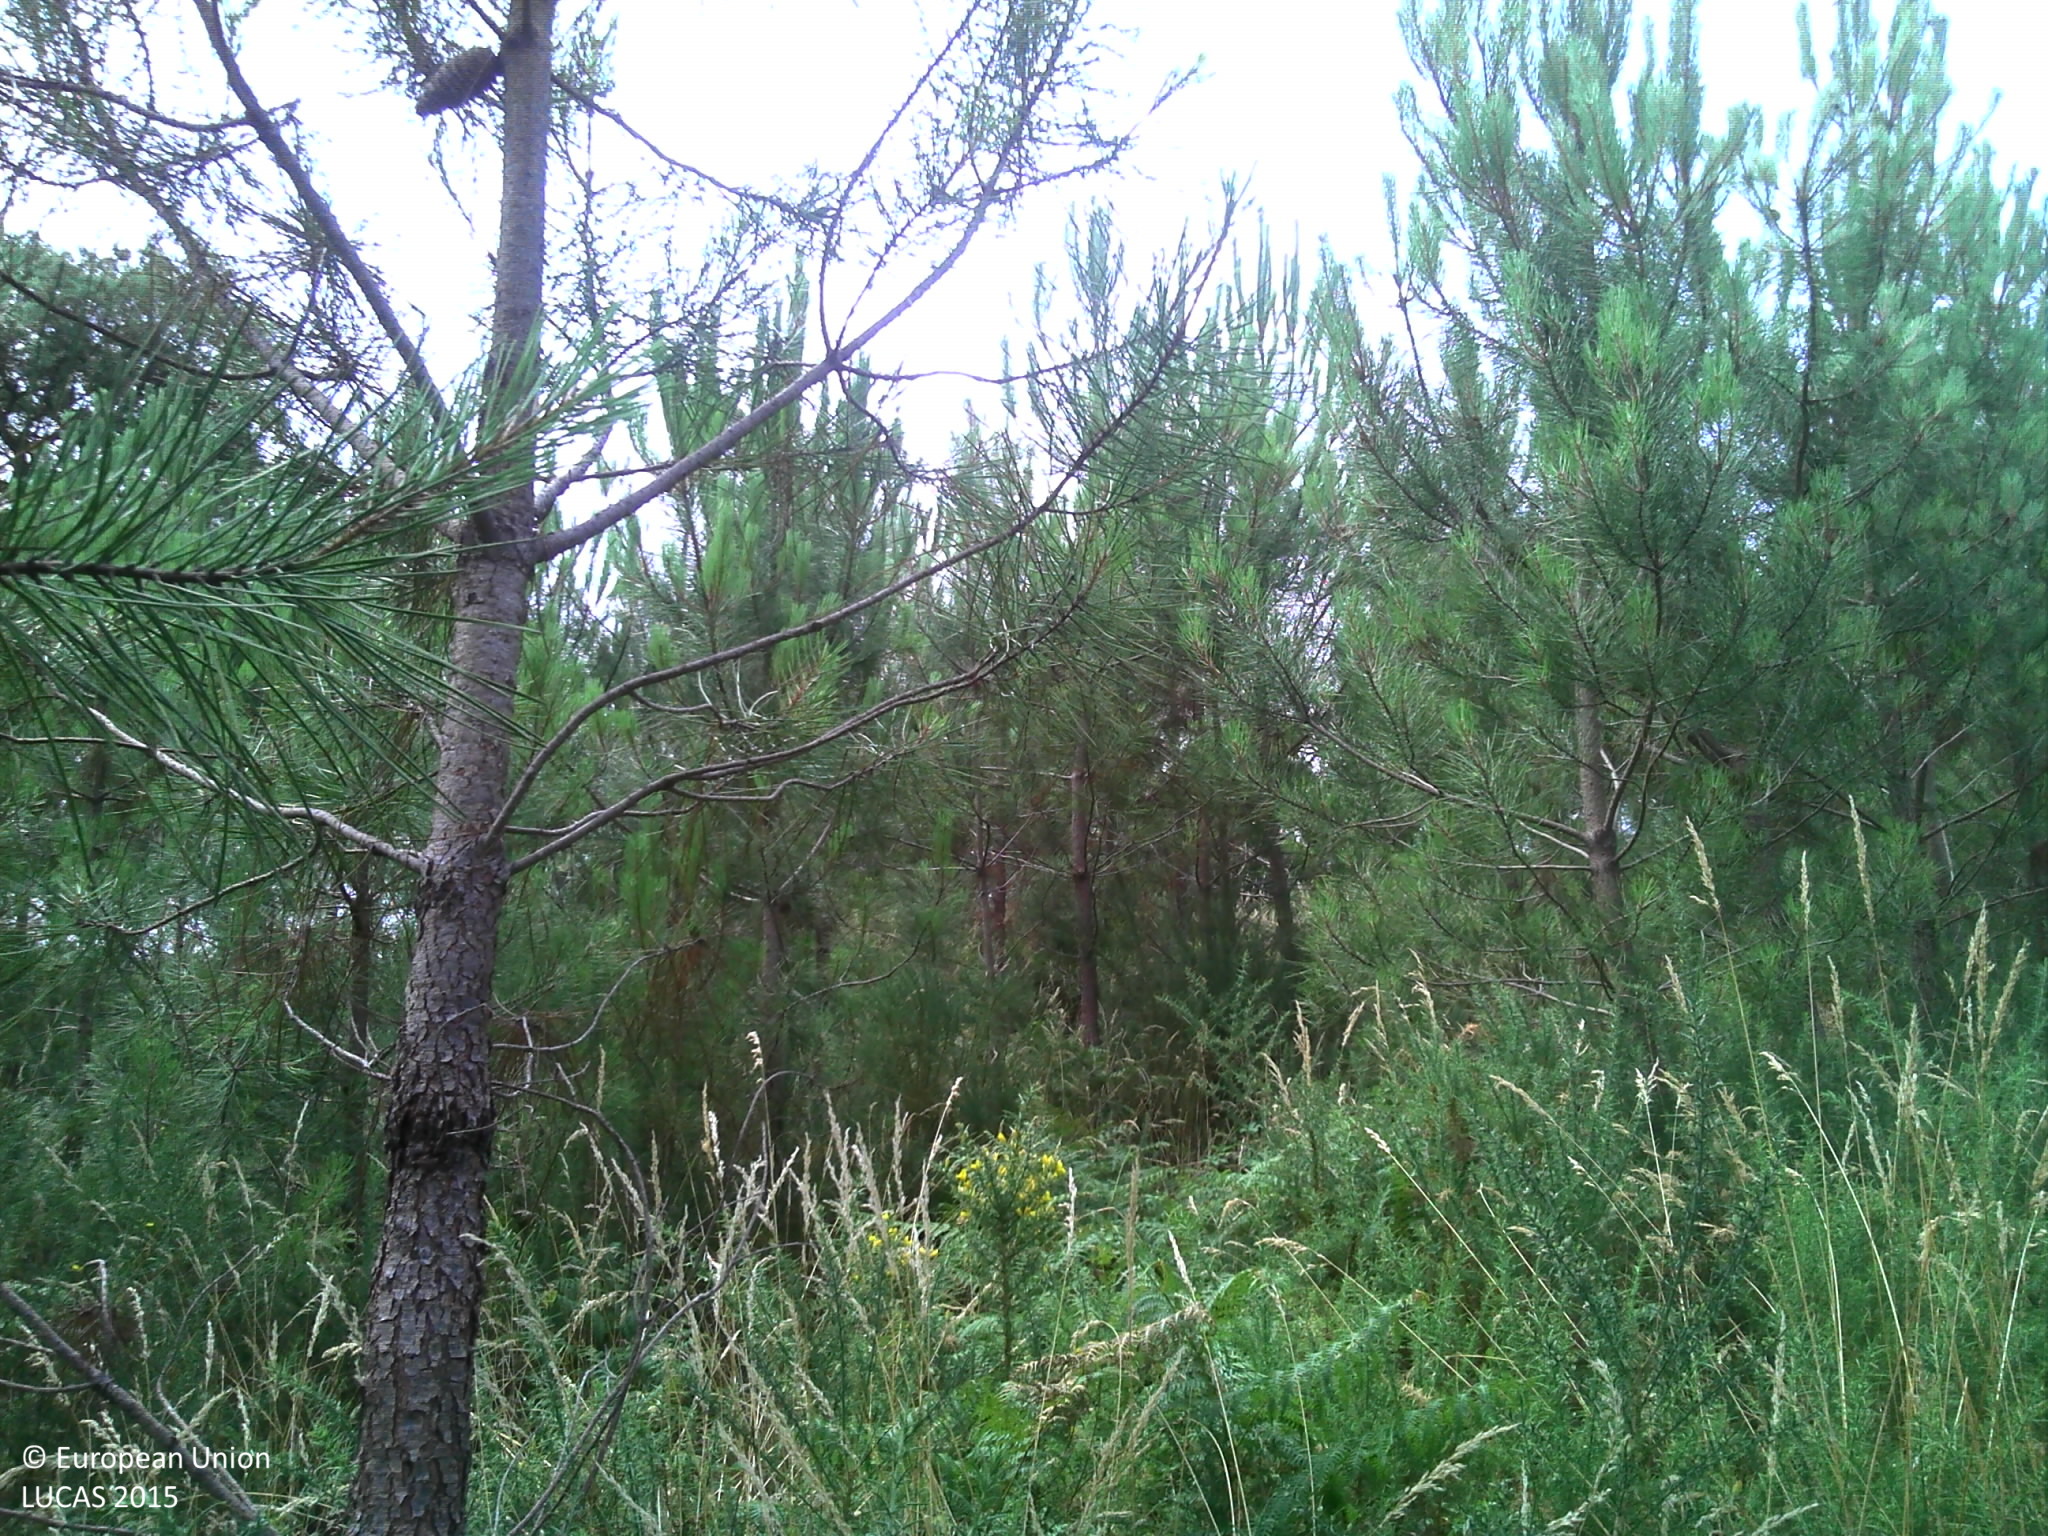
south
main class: Woodland
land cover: Pine dominated coniferous woodland
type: coniferous forest of the mediterranean region
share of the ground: > 75 %
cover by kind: coniferous forest trees 80 %, shrubs 10 %, herbaceous plants 10 %
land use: Forestry
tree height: < 5 m
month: July
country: FR
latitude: 43.7994
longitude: -1.3421
